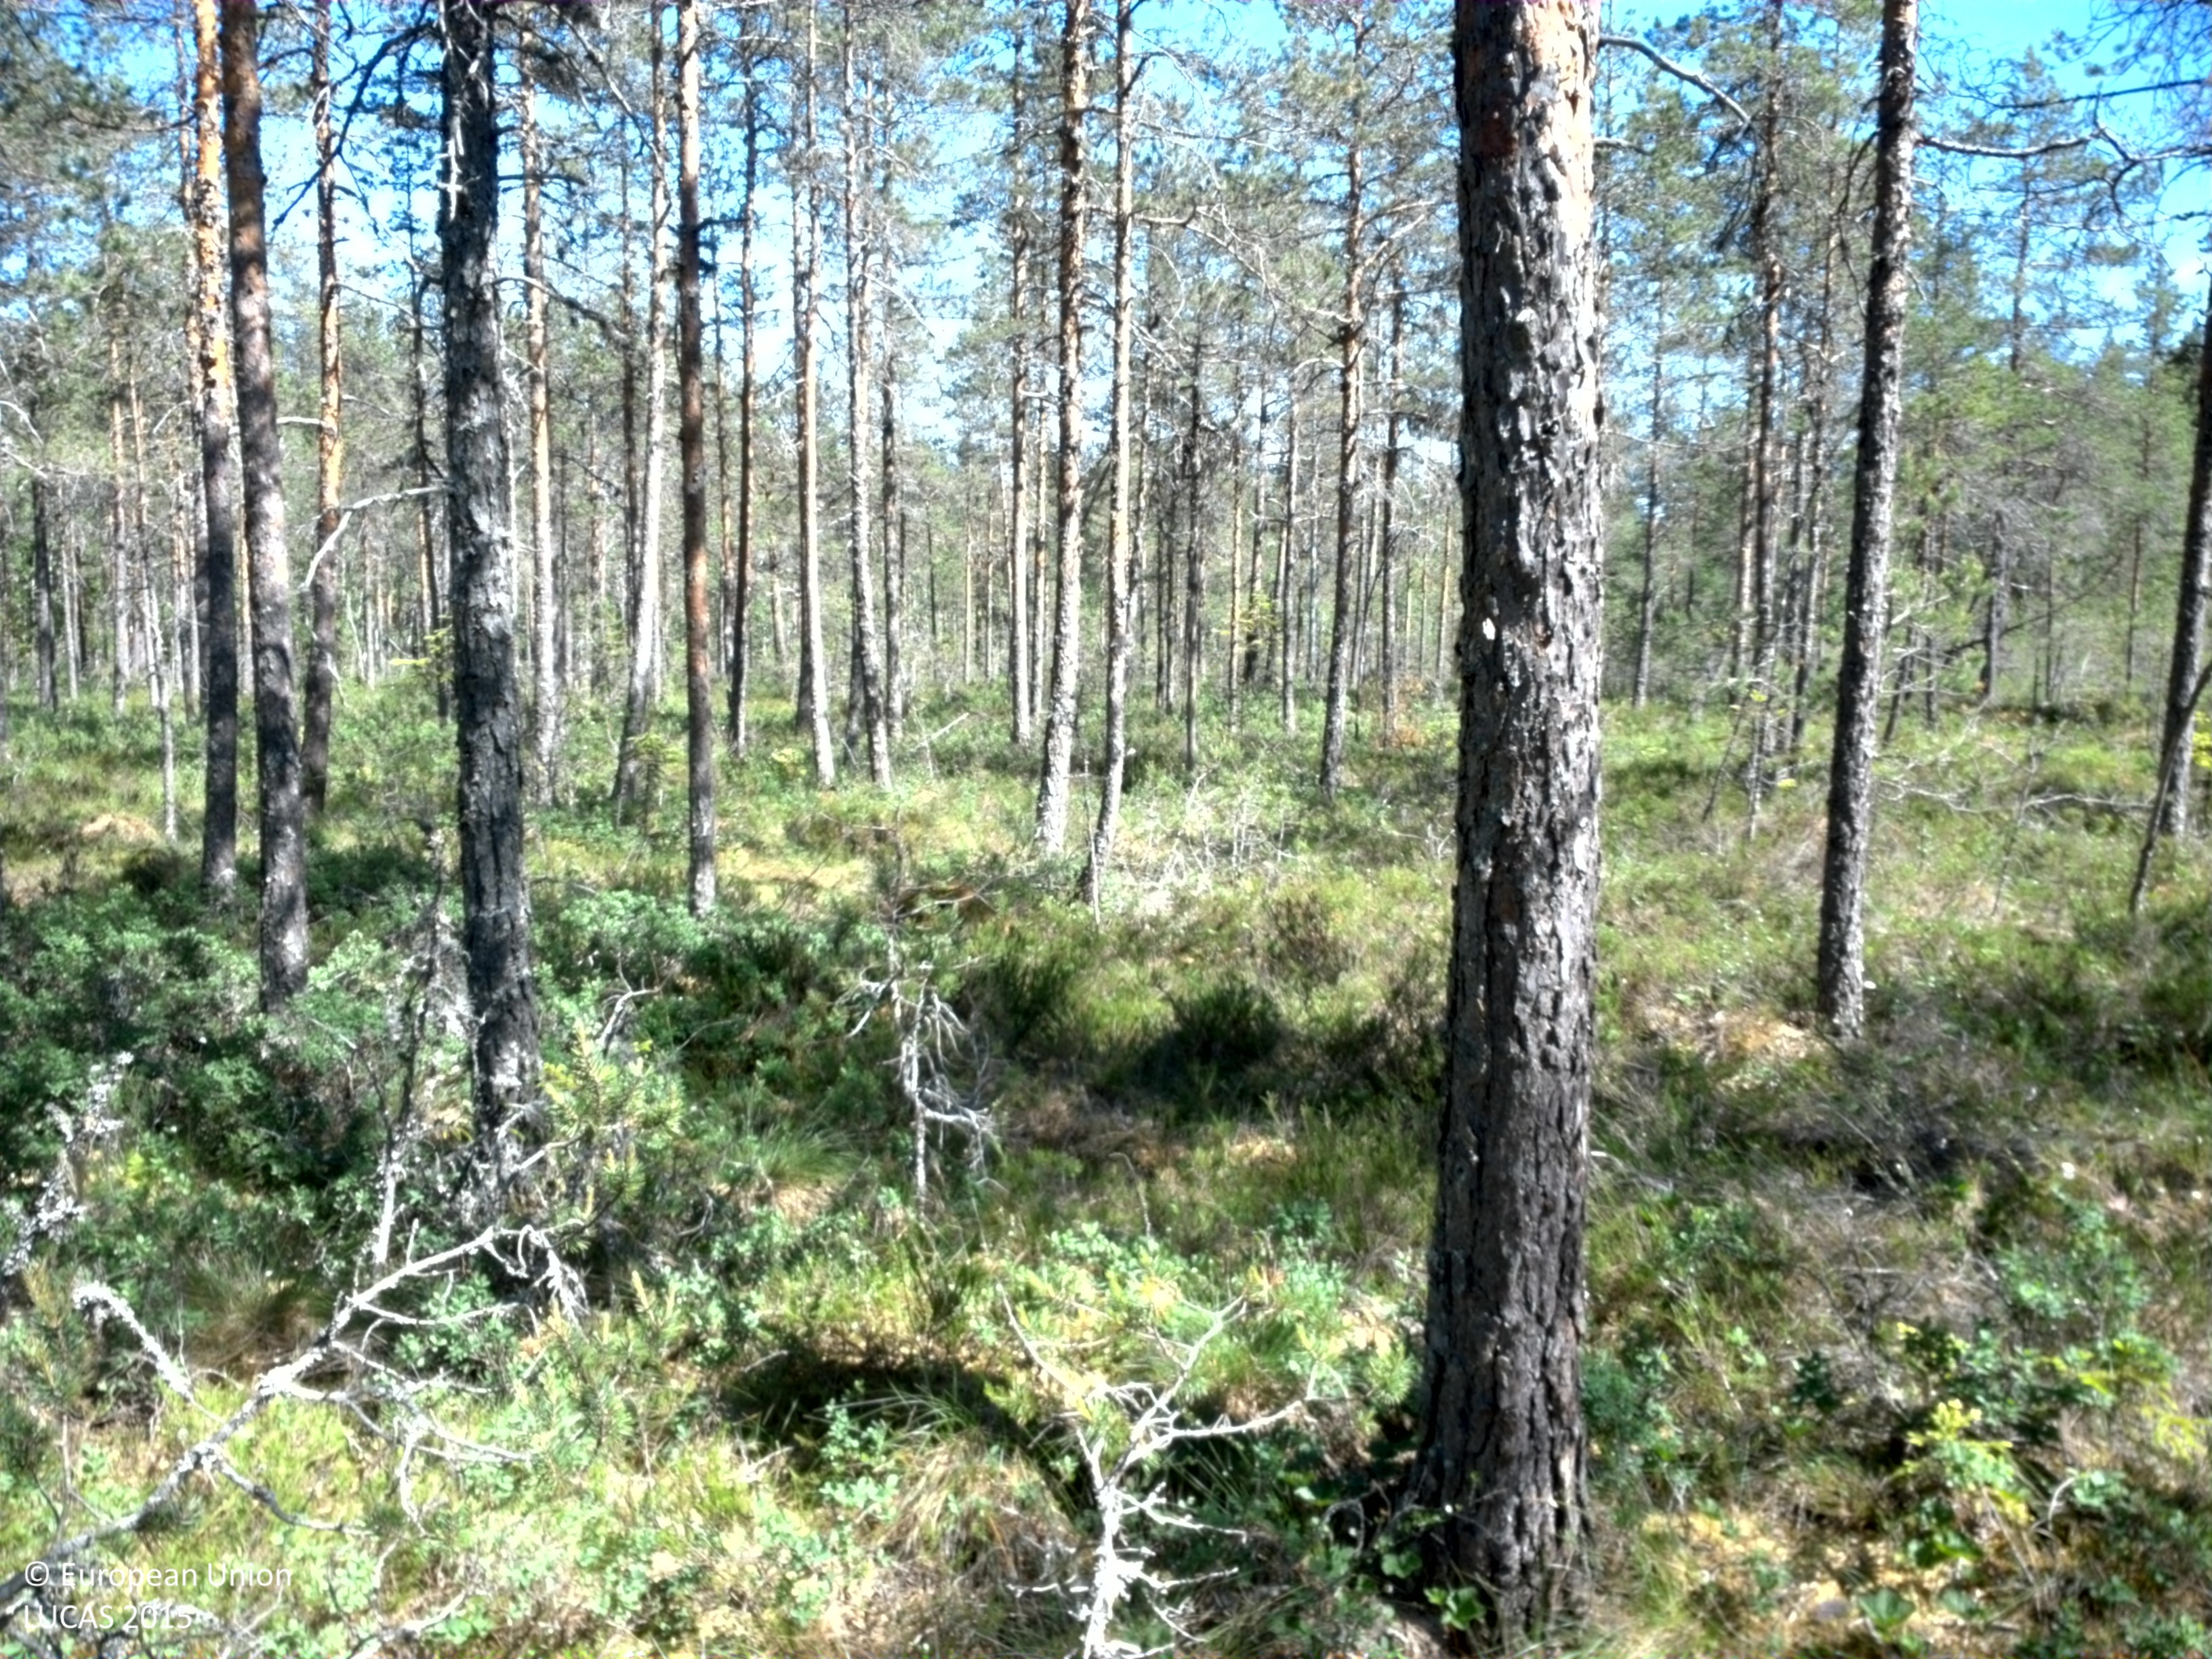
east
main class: Woodland
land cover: Pine dominated coniferous woodland
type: mire and swamp forests
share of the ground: 10 - 25 %
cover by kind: shrubs 50 %, lichens and mosses 30 %, coniferous forest trees 20 %
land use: Semi-natural and natural areas not in use
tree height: > 5 m
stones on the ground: < 10 %
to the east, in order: Pine dominated coniferous woodland; Broadleaved woodland; Peatbogs; Inland fresh running water; Grassland with sparse tree/shrub cover; Spruce dominated mixed woodland; Peatbogs
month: July
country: SE
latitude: 60.4177
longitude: 13.0598
